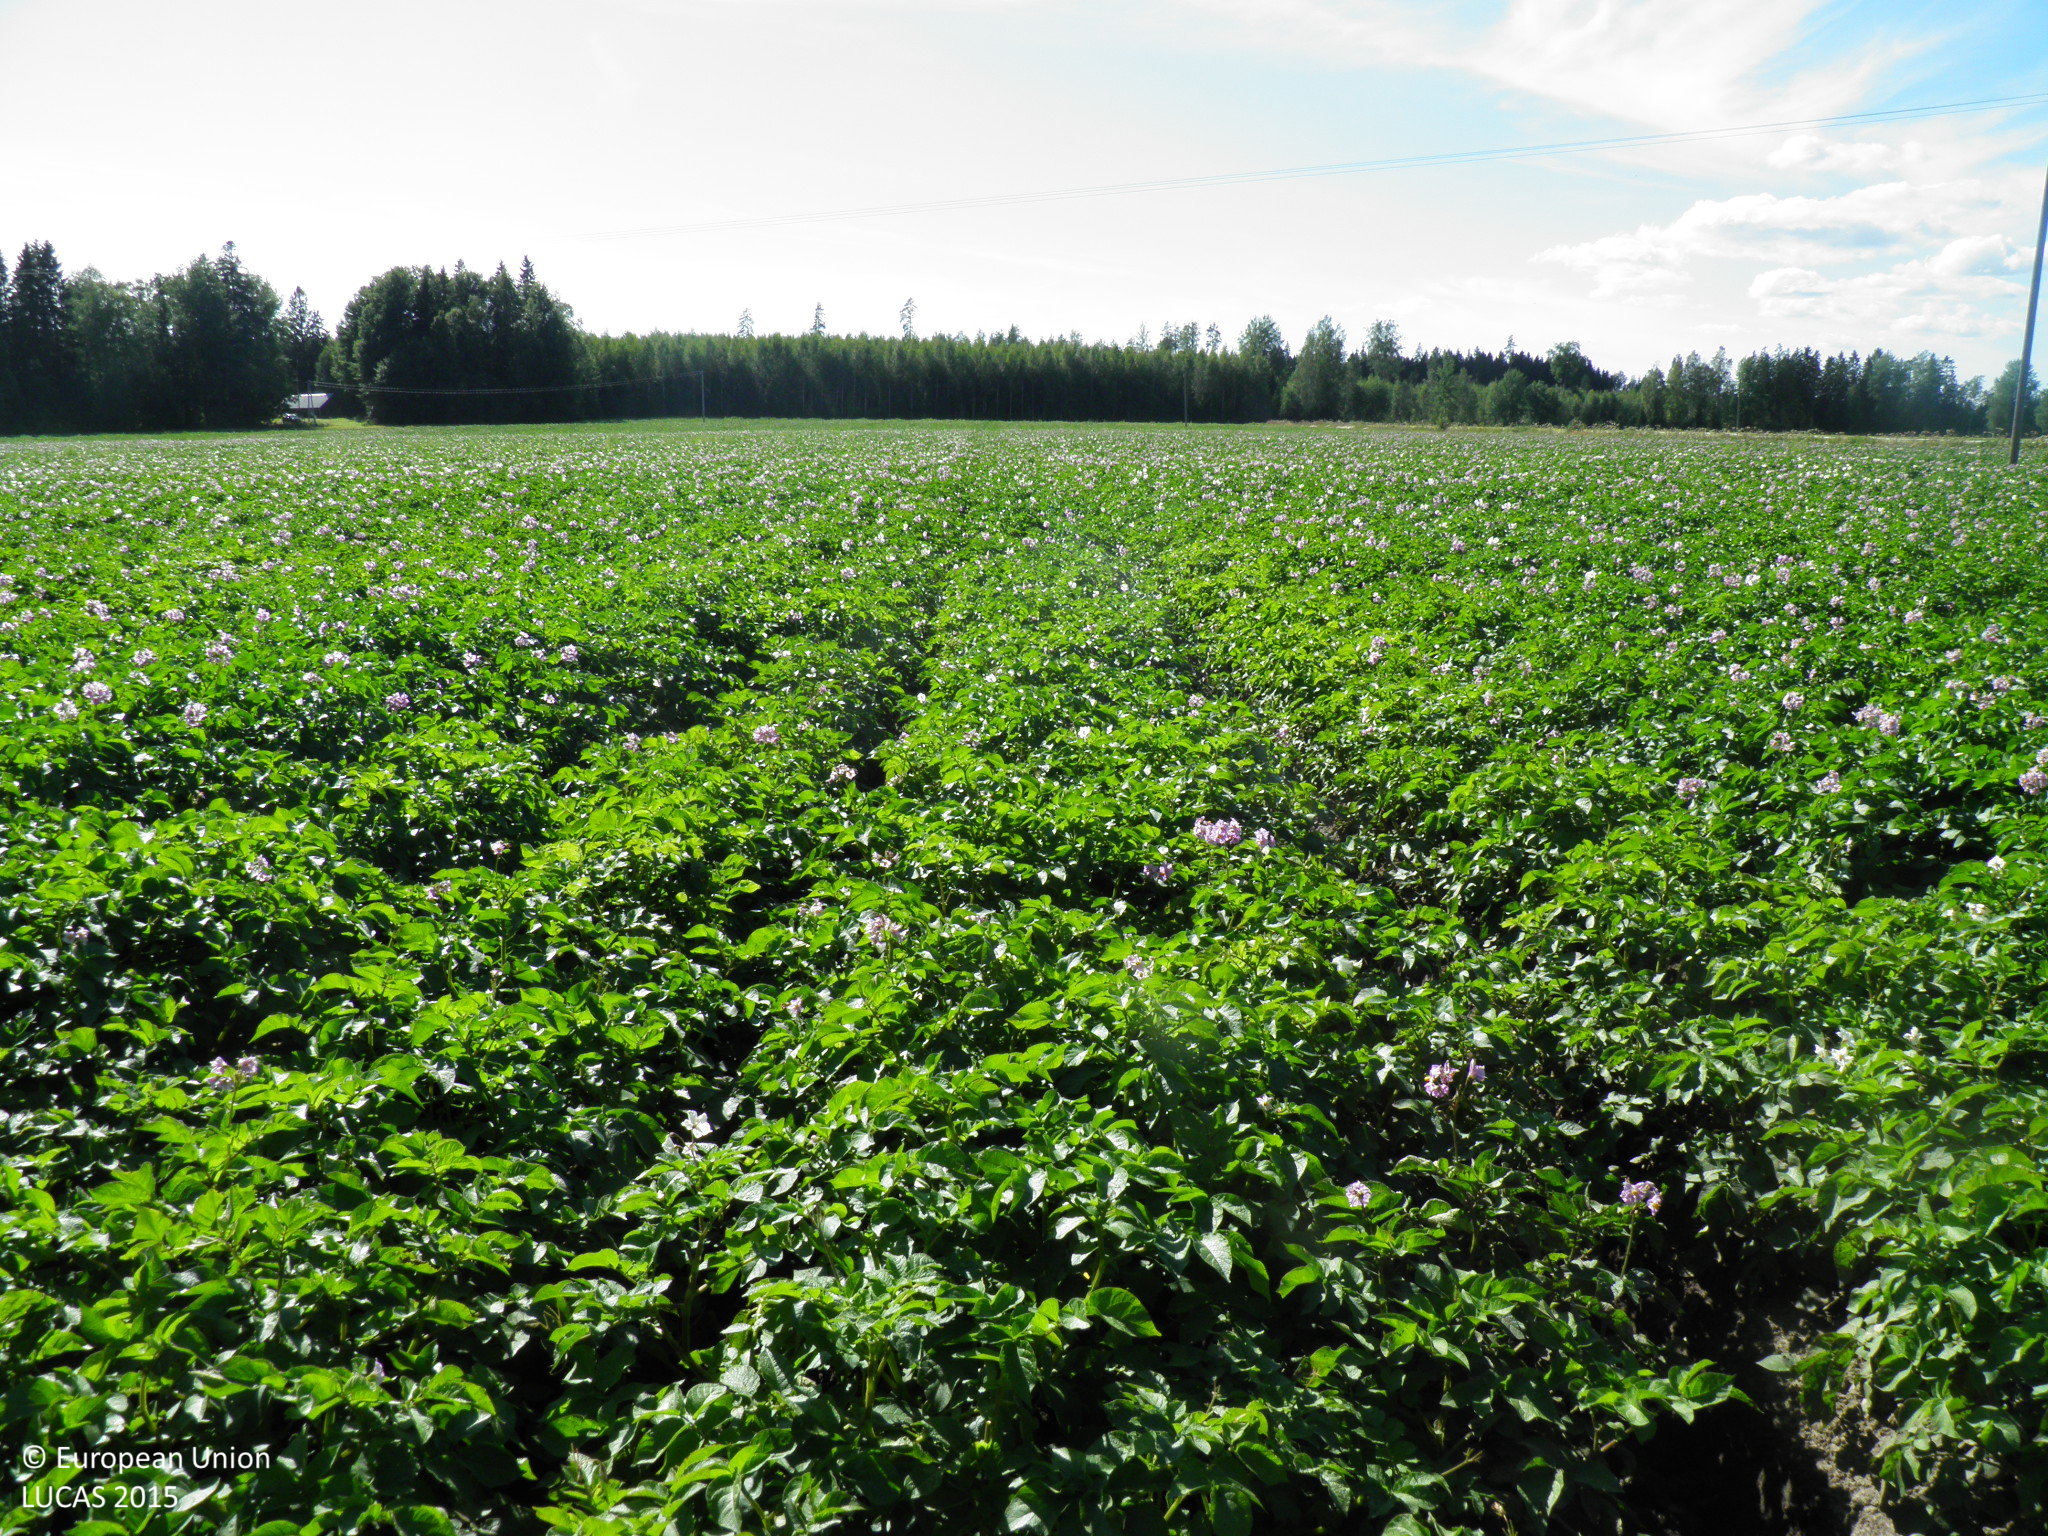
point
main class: Cropland
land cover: Potatoes
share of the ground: > 75 %
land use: Agriculture (excluding fallow land and kitchen gardens)
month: August
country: FI
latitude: 61.0796
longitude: 22.5426
